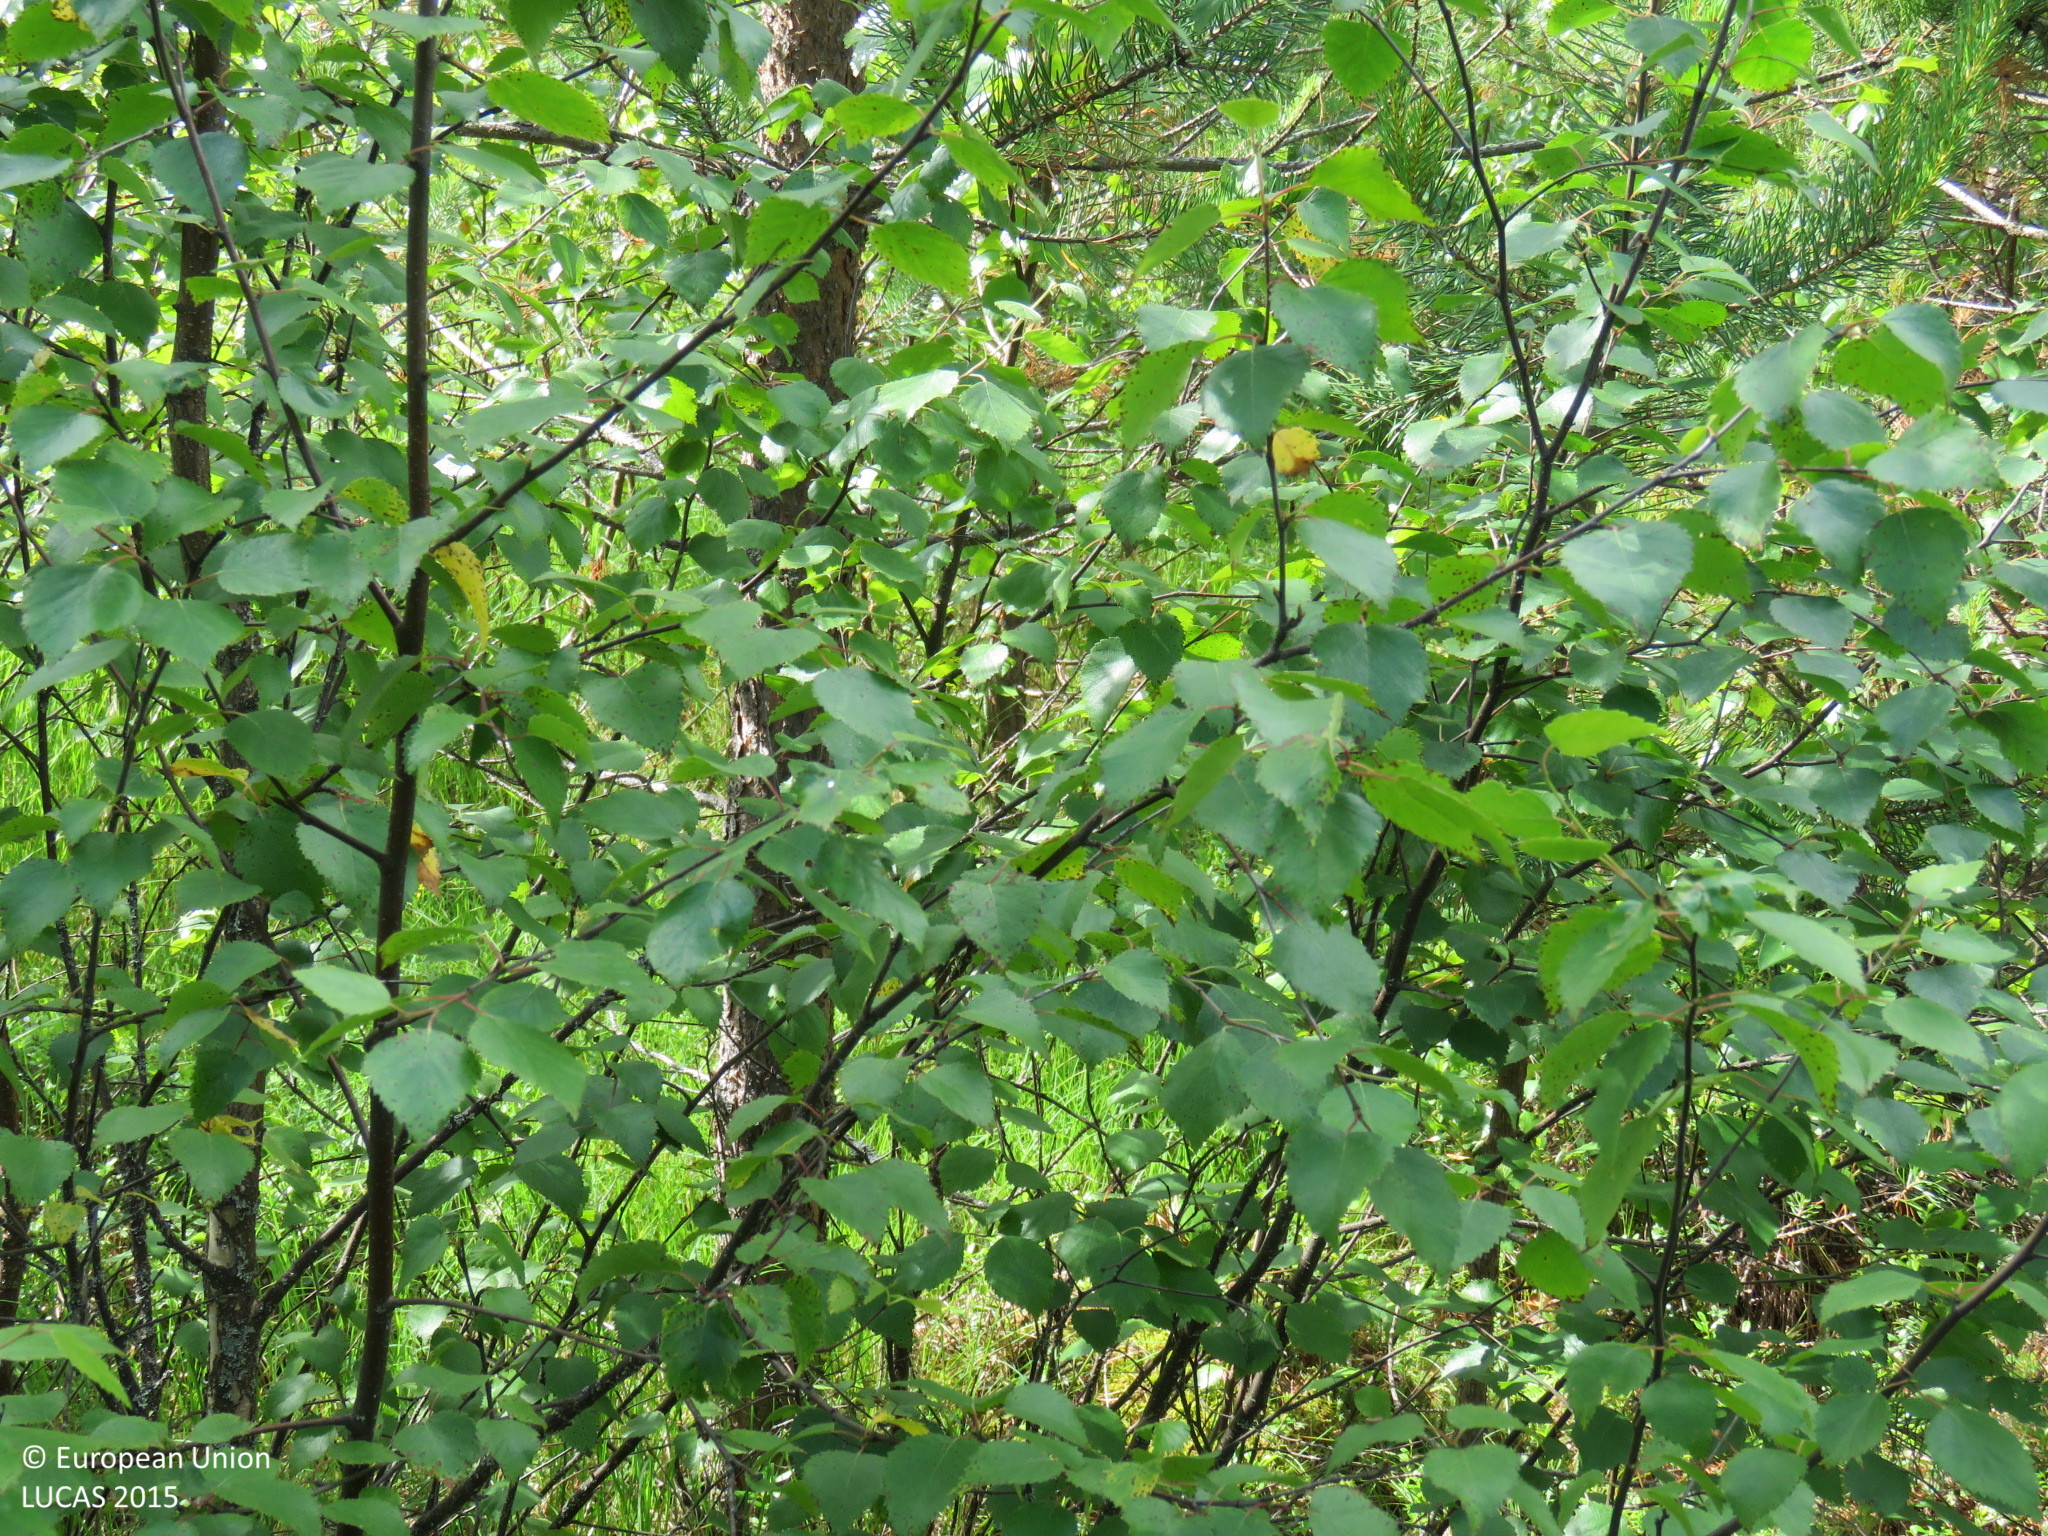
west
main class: Woodland
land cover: Pine dominated mixed woodland
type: boreal forest
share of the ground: > 75 %
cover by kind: broadleaved forest trees 50 %, coniferous forest trees 45 %, shrubs 5 %
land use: Forestry
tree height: < 5 m
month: July
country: FI
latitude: 64.6384
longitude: 26.4964
